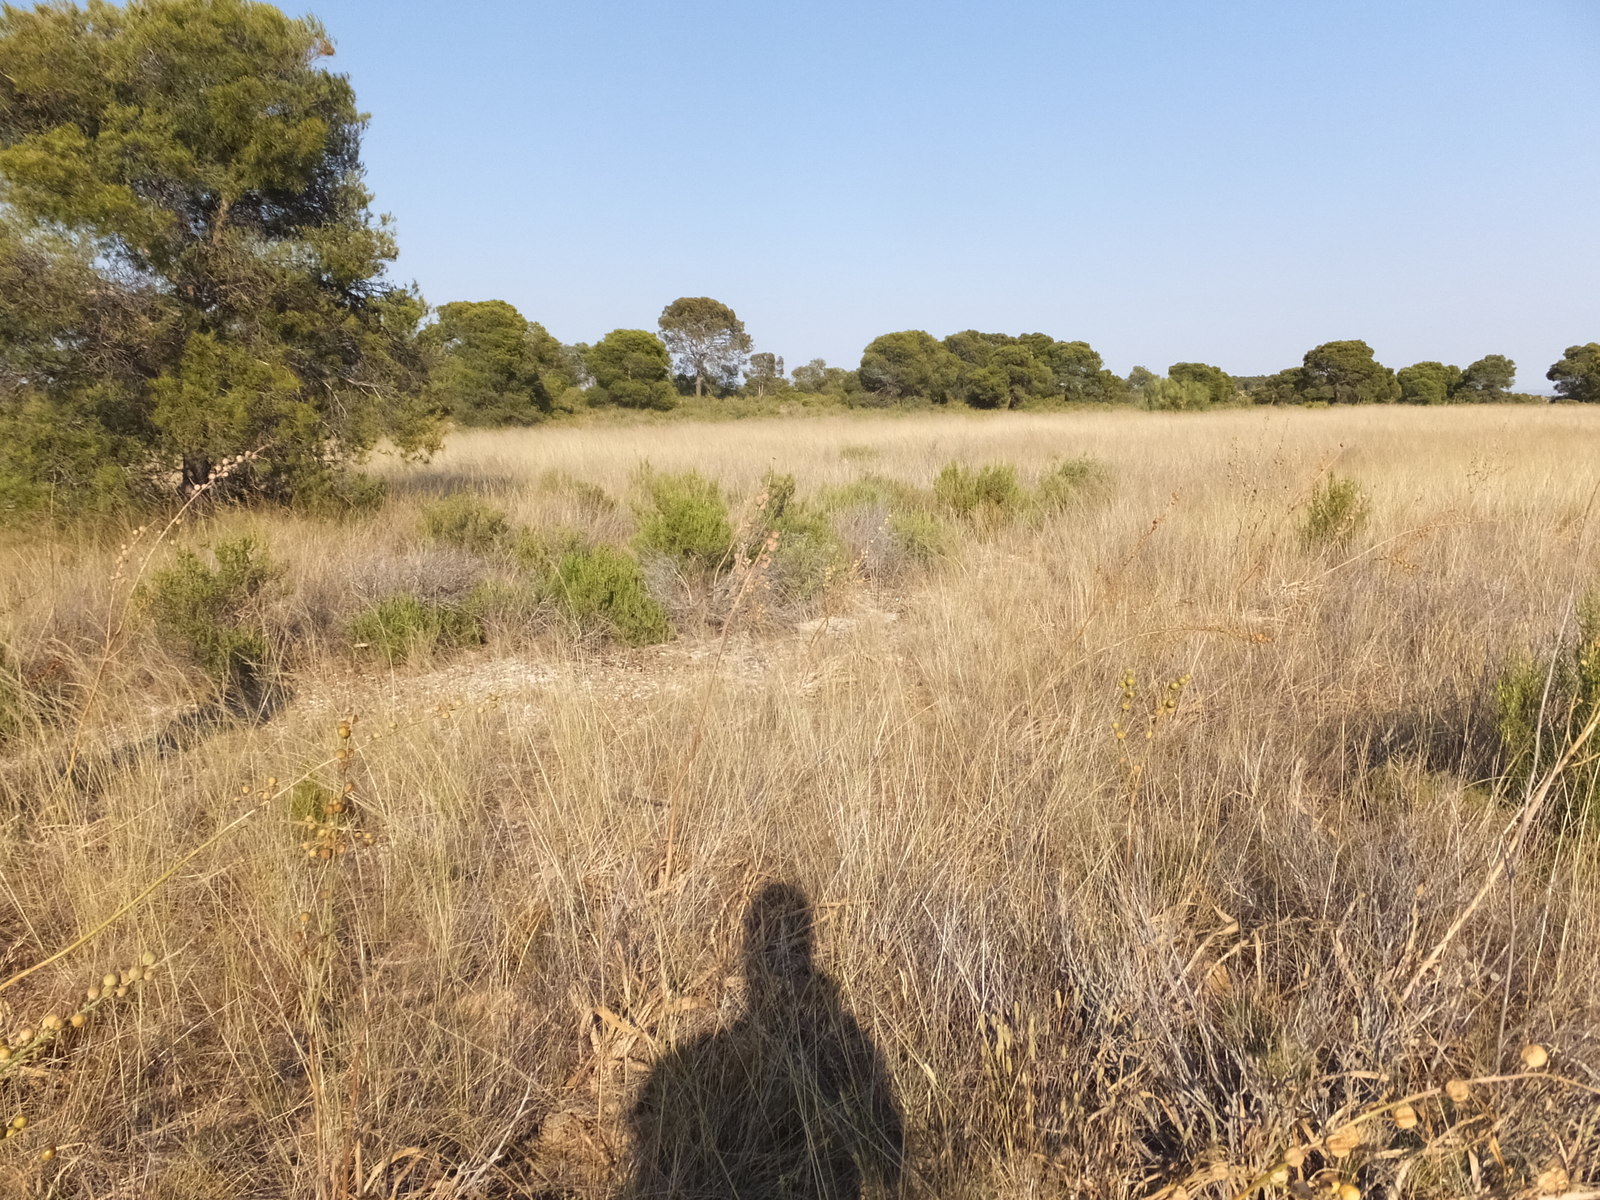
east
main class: Grassland
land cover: Grassland with sparse tree/shrub cover
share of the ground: > 75 %
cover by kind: herbaceous plants 85 %, shrubs 10 %, coniferous forest trees 5 %
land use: Abandoned areas
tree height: > 5 m
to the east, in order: Grassland with sparse tree/shrub cover; Shrubland with sparse tree cover; Pine dominated mixed woodland
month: June
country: ES
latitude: 41.2779
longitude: -0.2456
